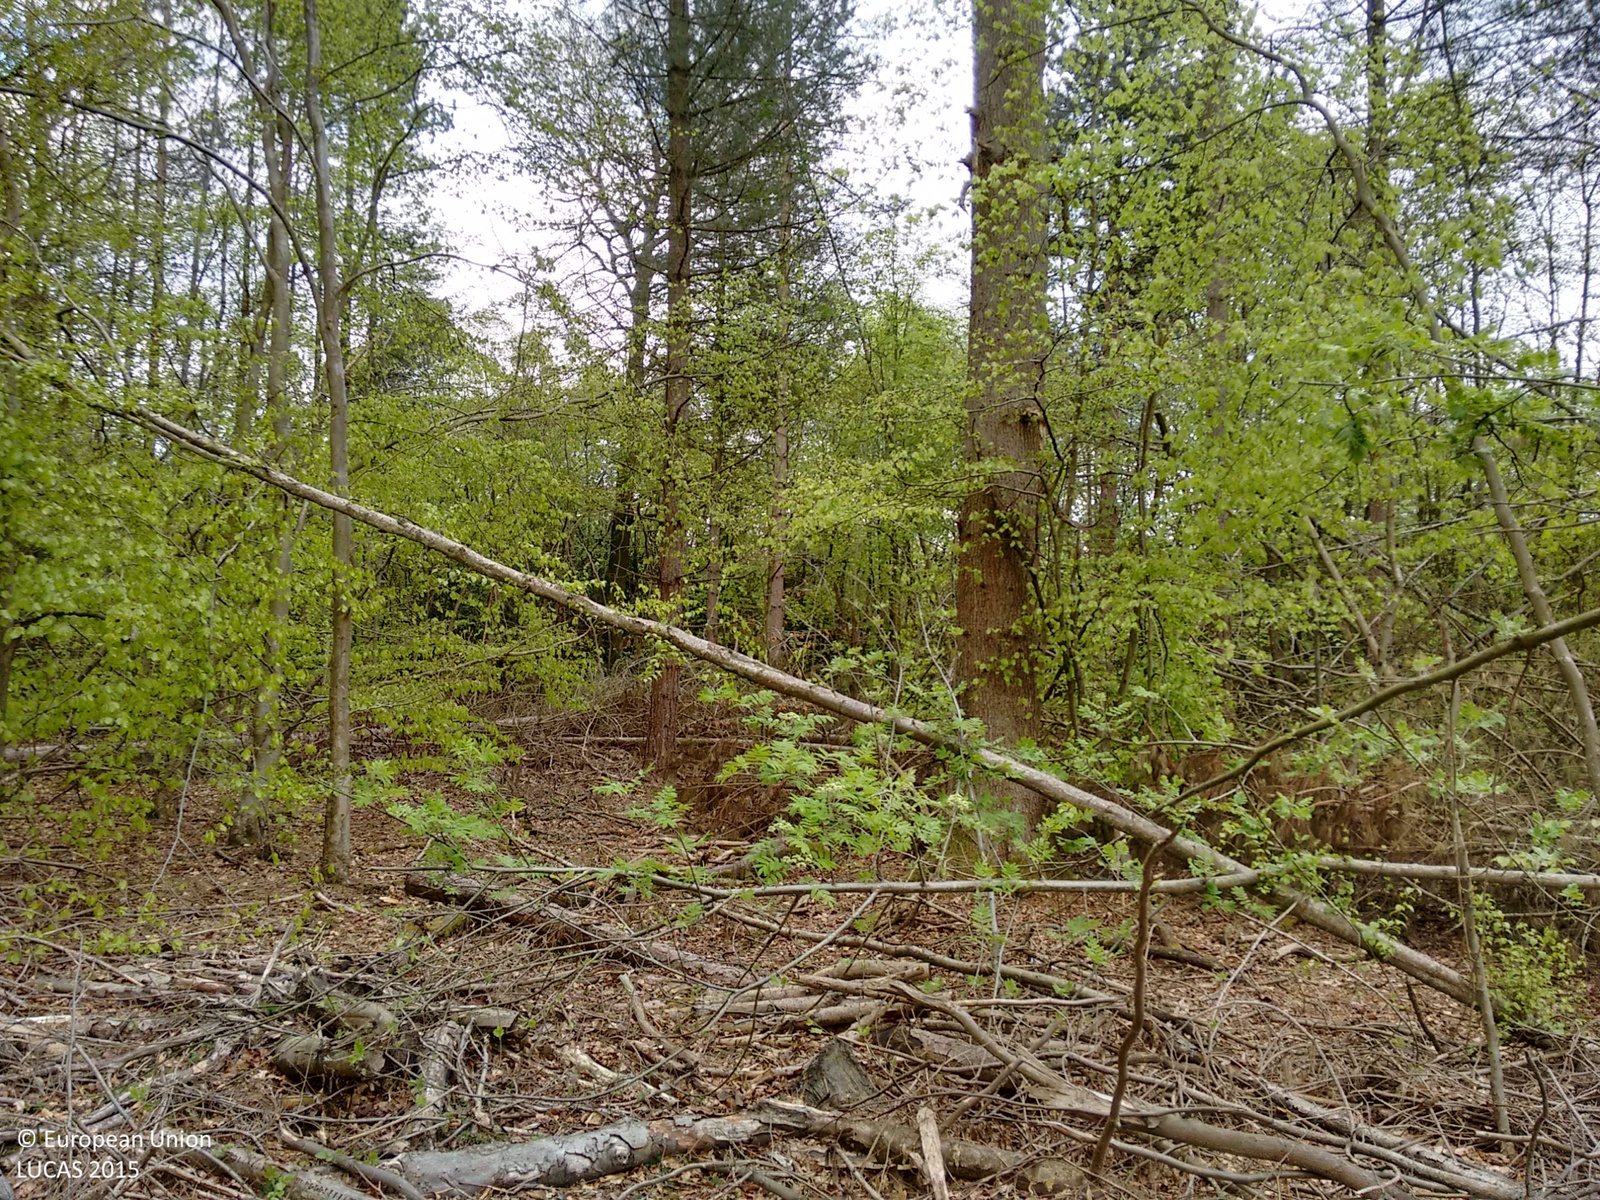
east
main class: Woodland
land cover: Pine dominated mixed woodland
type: mesophytic deciduous forest
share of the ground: 50 - 75 %
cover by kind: coniferous forest trees 60 %, broadleaved forest trees 30 %, shrubs 10 %
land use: Forestry
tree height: > 5 m
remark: Clear cut
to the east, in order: Pine dominated mixed woodland; Grassland without tree/shrub cover; Managed hedges; Paved roads, cycling and walking lanes; Broadleaved woodland
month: April
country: GB
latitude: 51.6597
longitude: -0.6656
